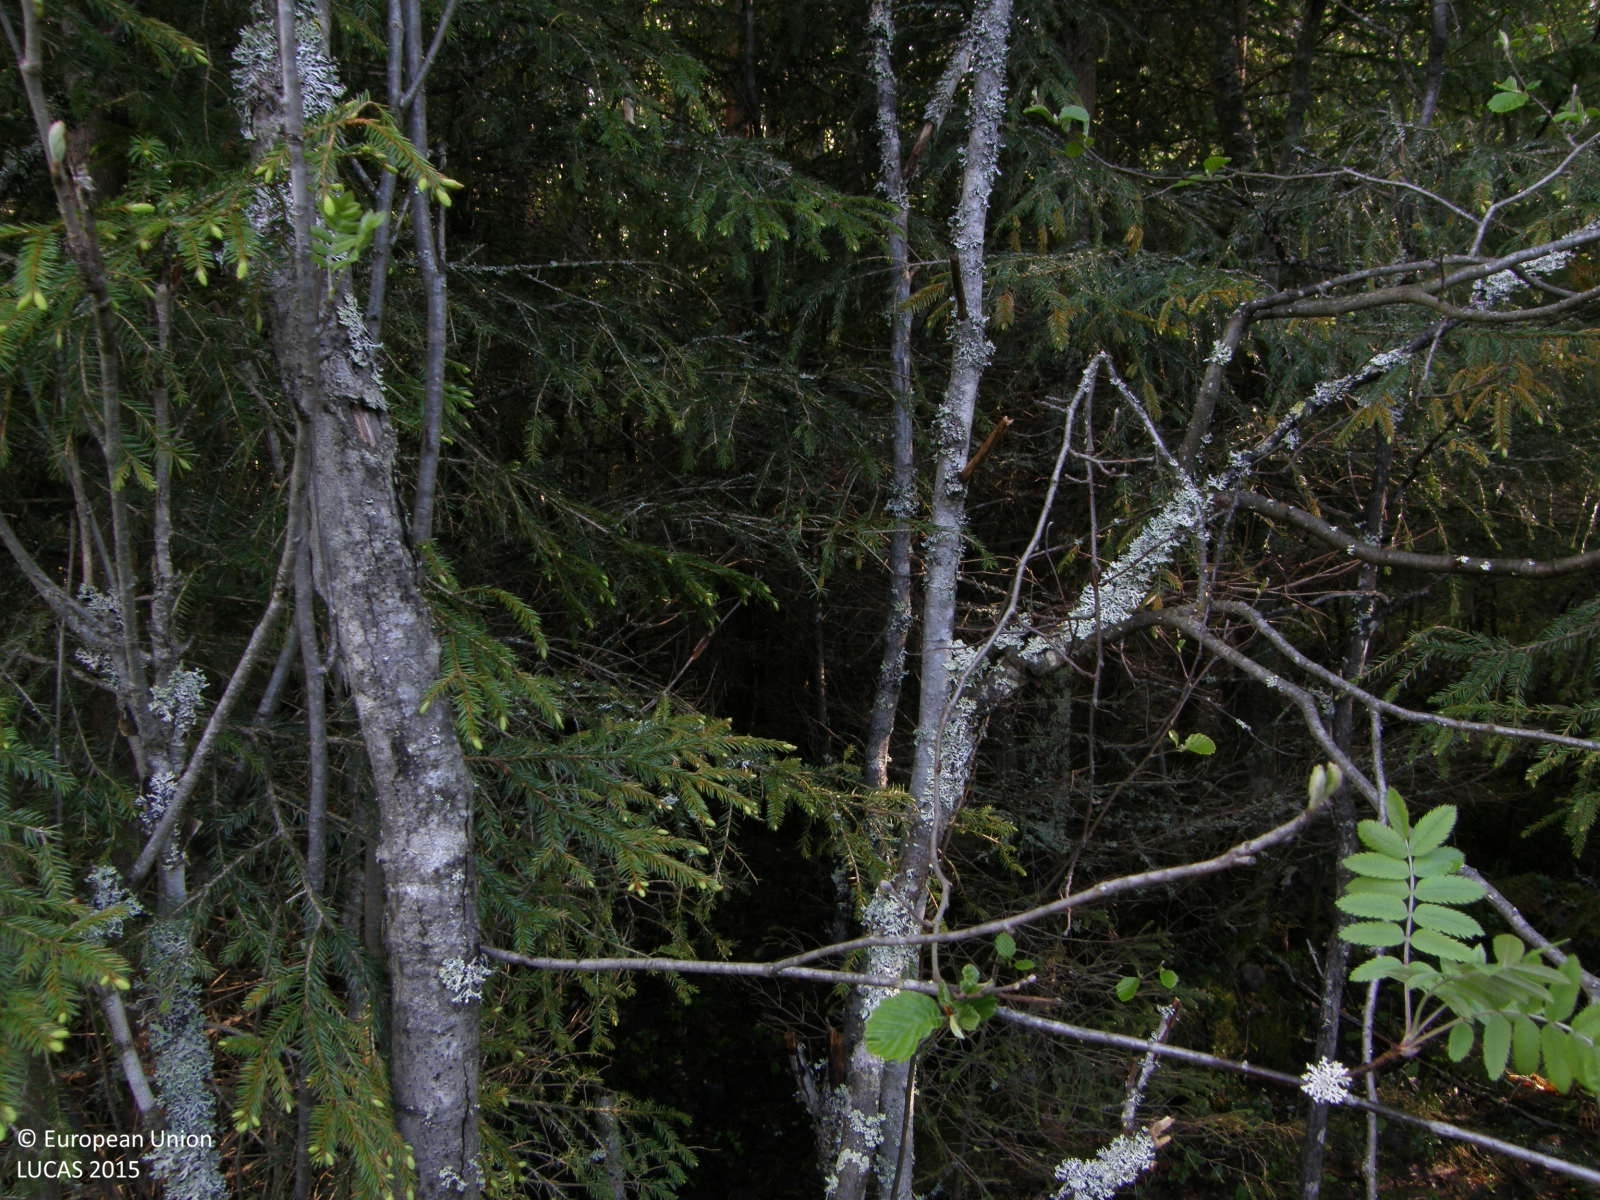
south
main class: Woodland
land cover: Spruce dominated mixed woodland
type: boreal forest
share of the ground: > 75 %
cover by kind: coniferous forest trees 50 %, broadleaved forest trees 25 %, herbaceous plants 25 %
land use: Forestry
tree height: > 5 m
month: June
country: FI
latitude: 62.0071
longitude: 21.7185
